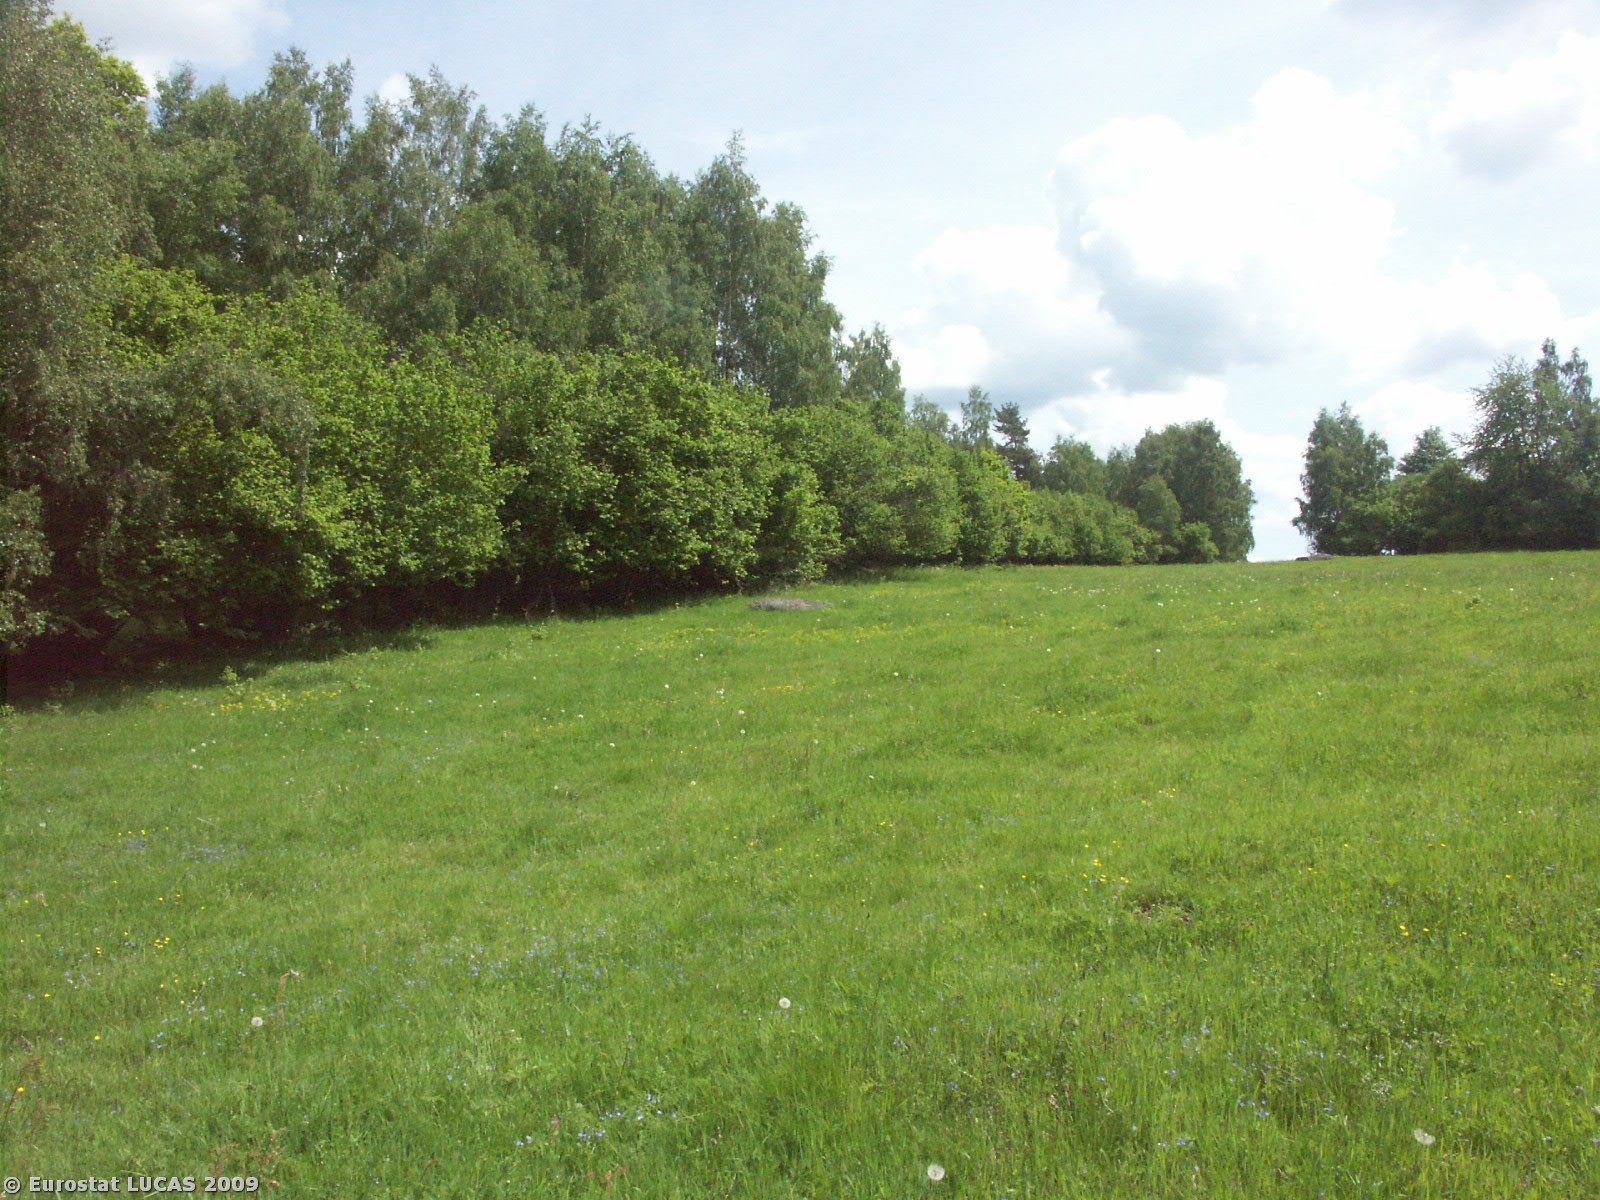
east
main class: Grassland
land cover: Grassland without tree/shrub cover
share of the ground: > 75 %
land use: Agriculture (excluding fallow land and kitchen gardens)
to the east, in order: Grassland without tree/shrub cover; Broadleaved woodland; Grassland without tree/shrub cover; Broadleaved woodland; Grassland without tree/shrub cover; Tracks; Mixed woodland; Grassland without tree/shrub cover; Broadleaved woodland; Tracks; Mixed woodland
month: May
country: CZ
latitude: 48.7219
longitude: 14.6092
